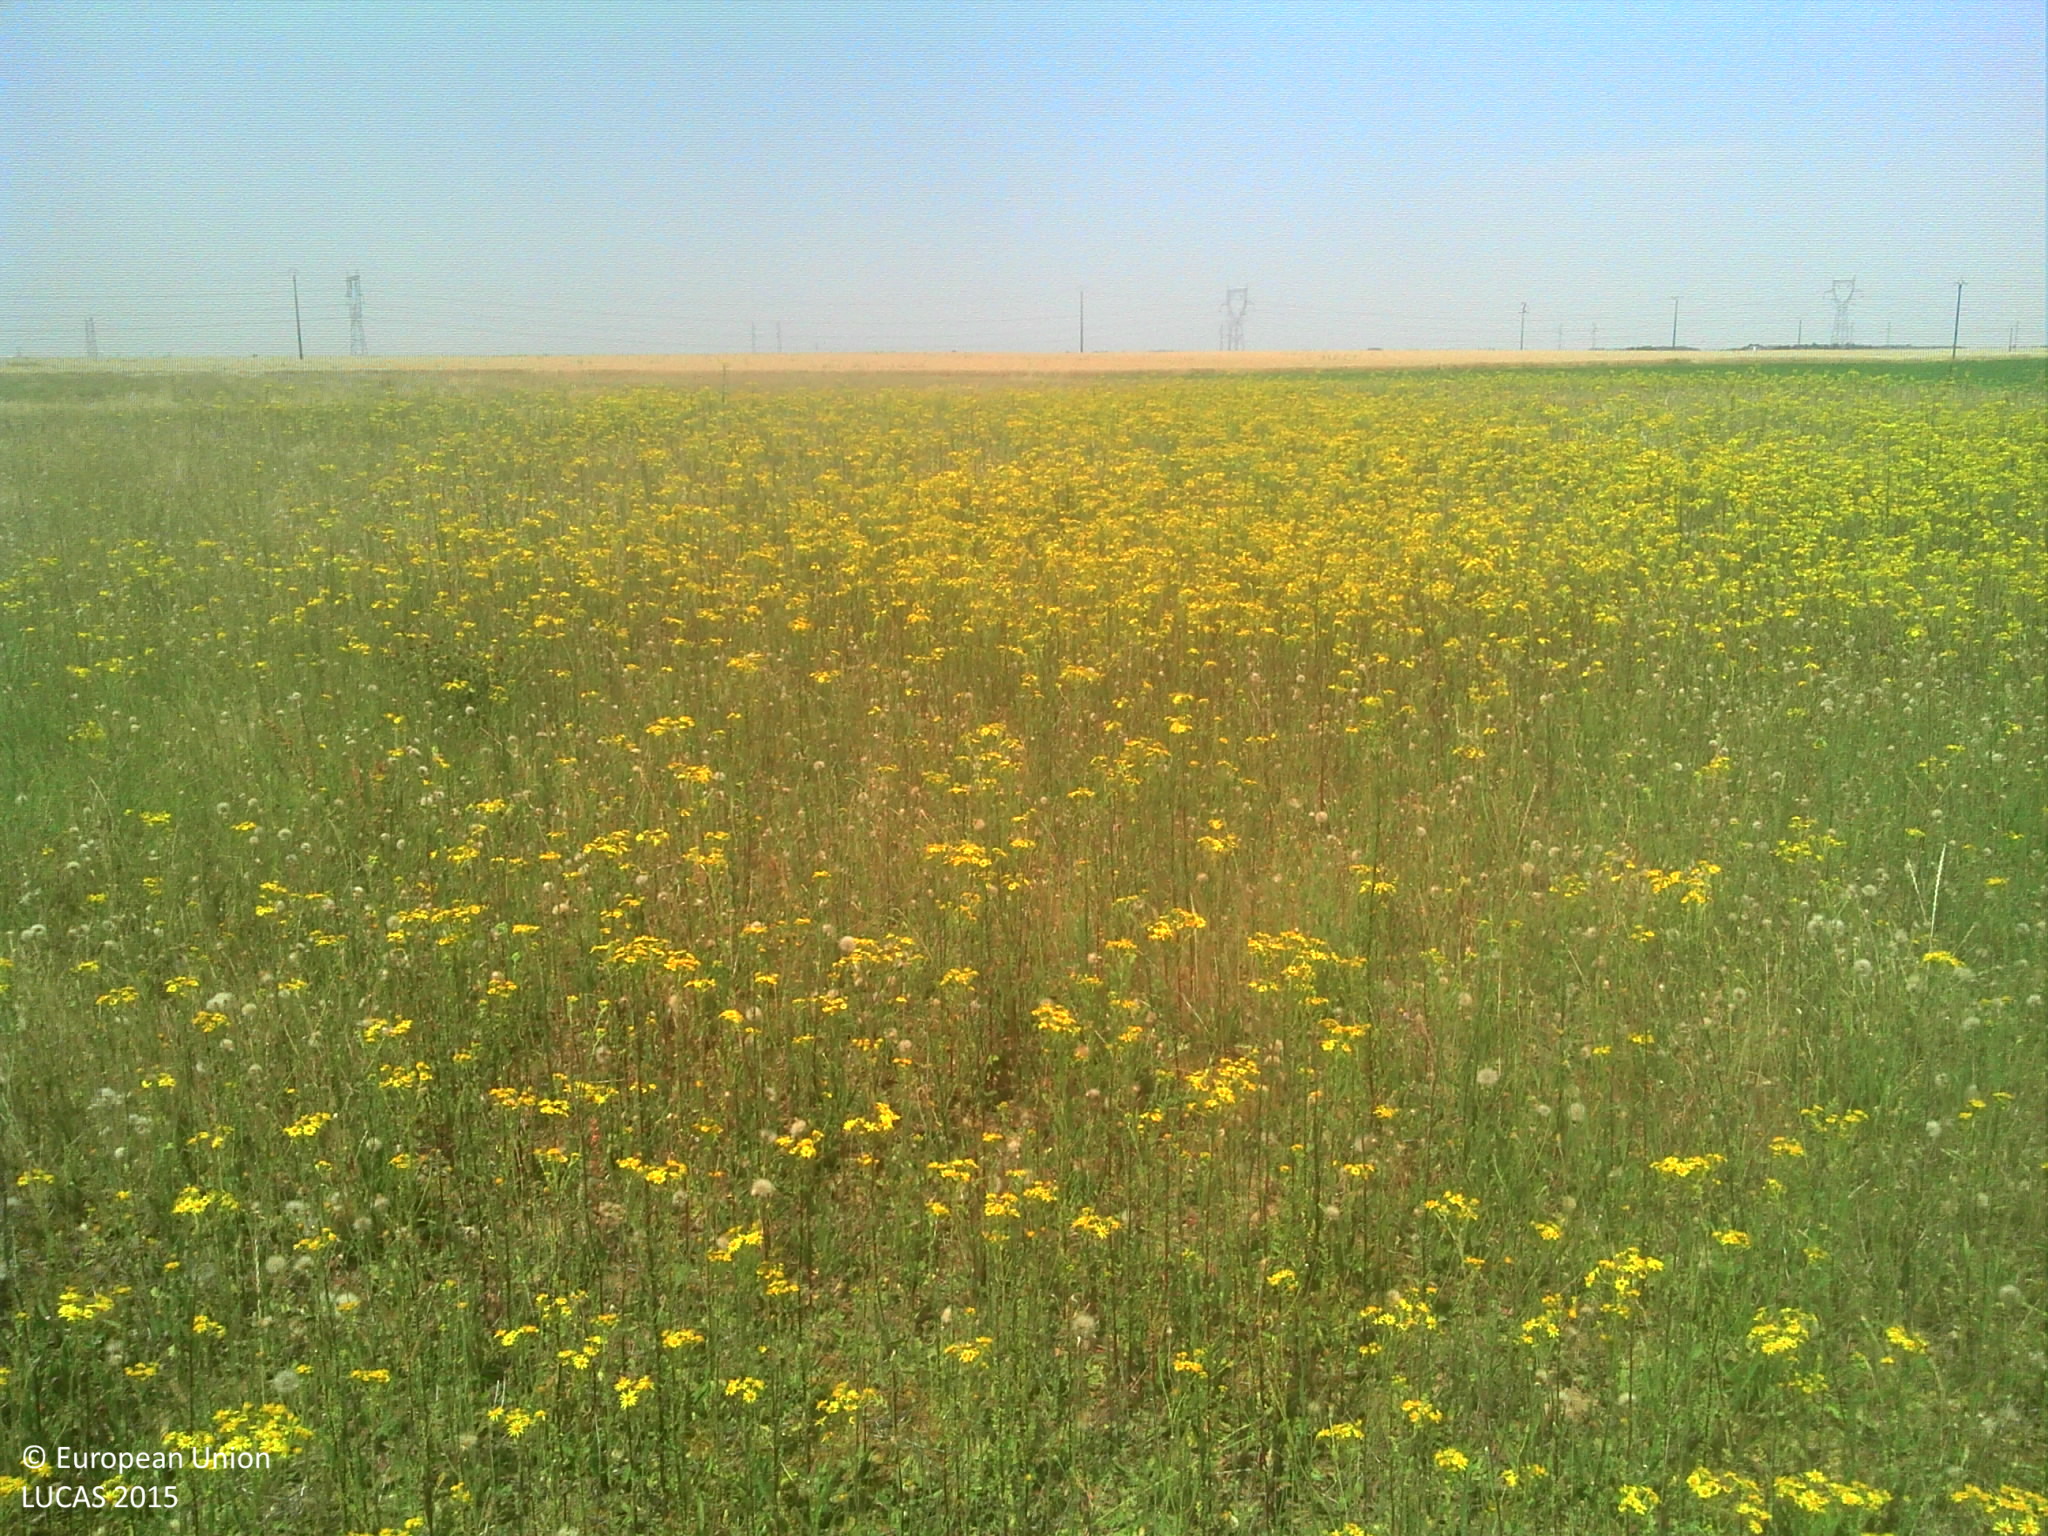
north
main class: Grassland
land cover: Spontaneously vegetated surfaces
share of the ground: > 75 %
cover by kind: herbaceous plants 100 %
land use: Agriculture (excluding fallow land and kitchen gardens)
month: July
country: FR
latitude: 47.6474
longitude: 1.3448
